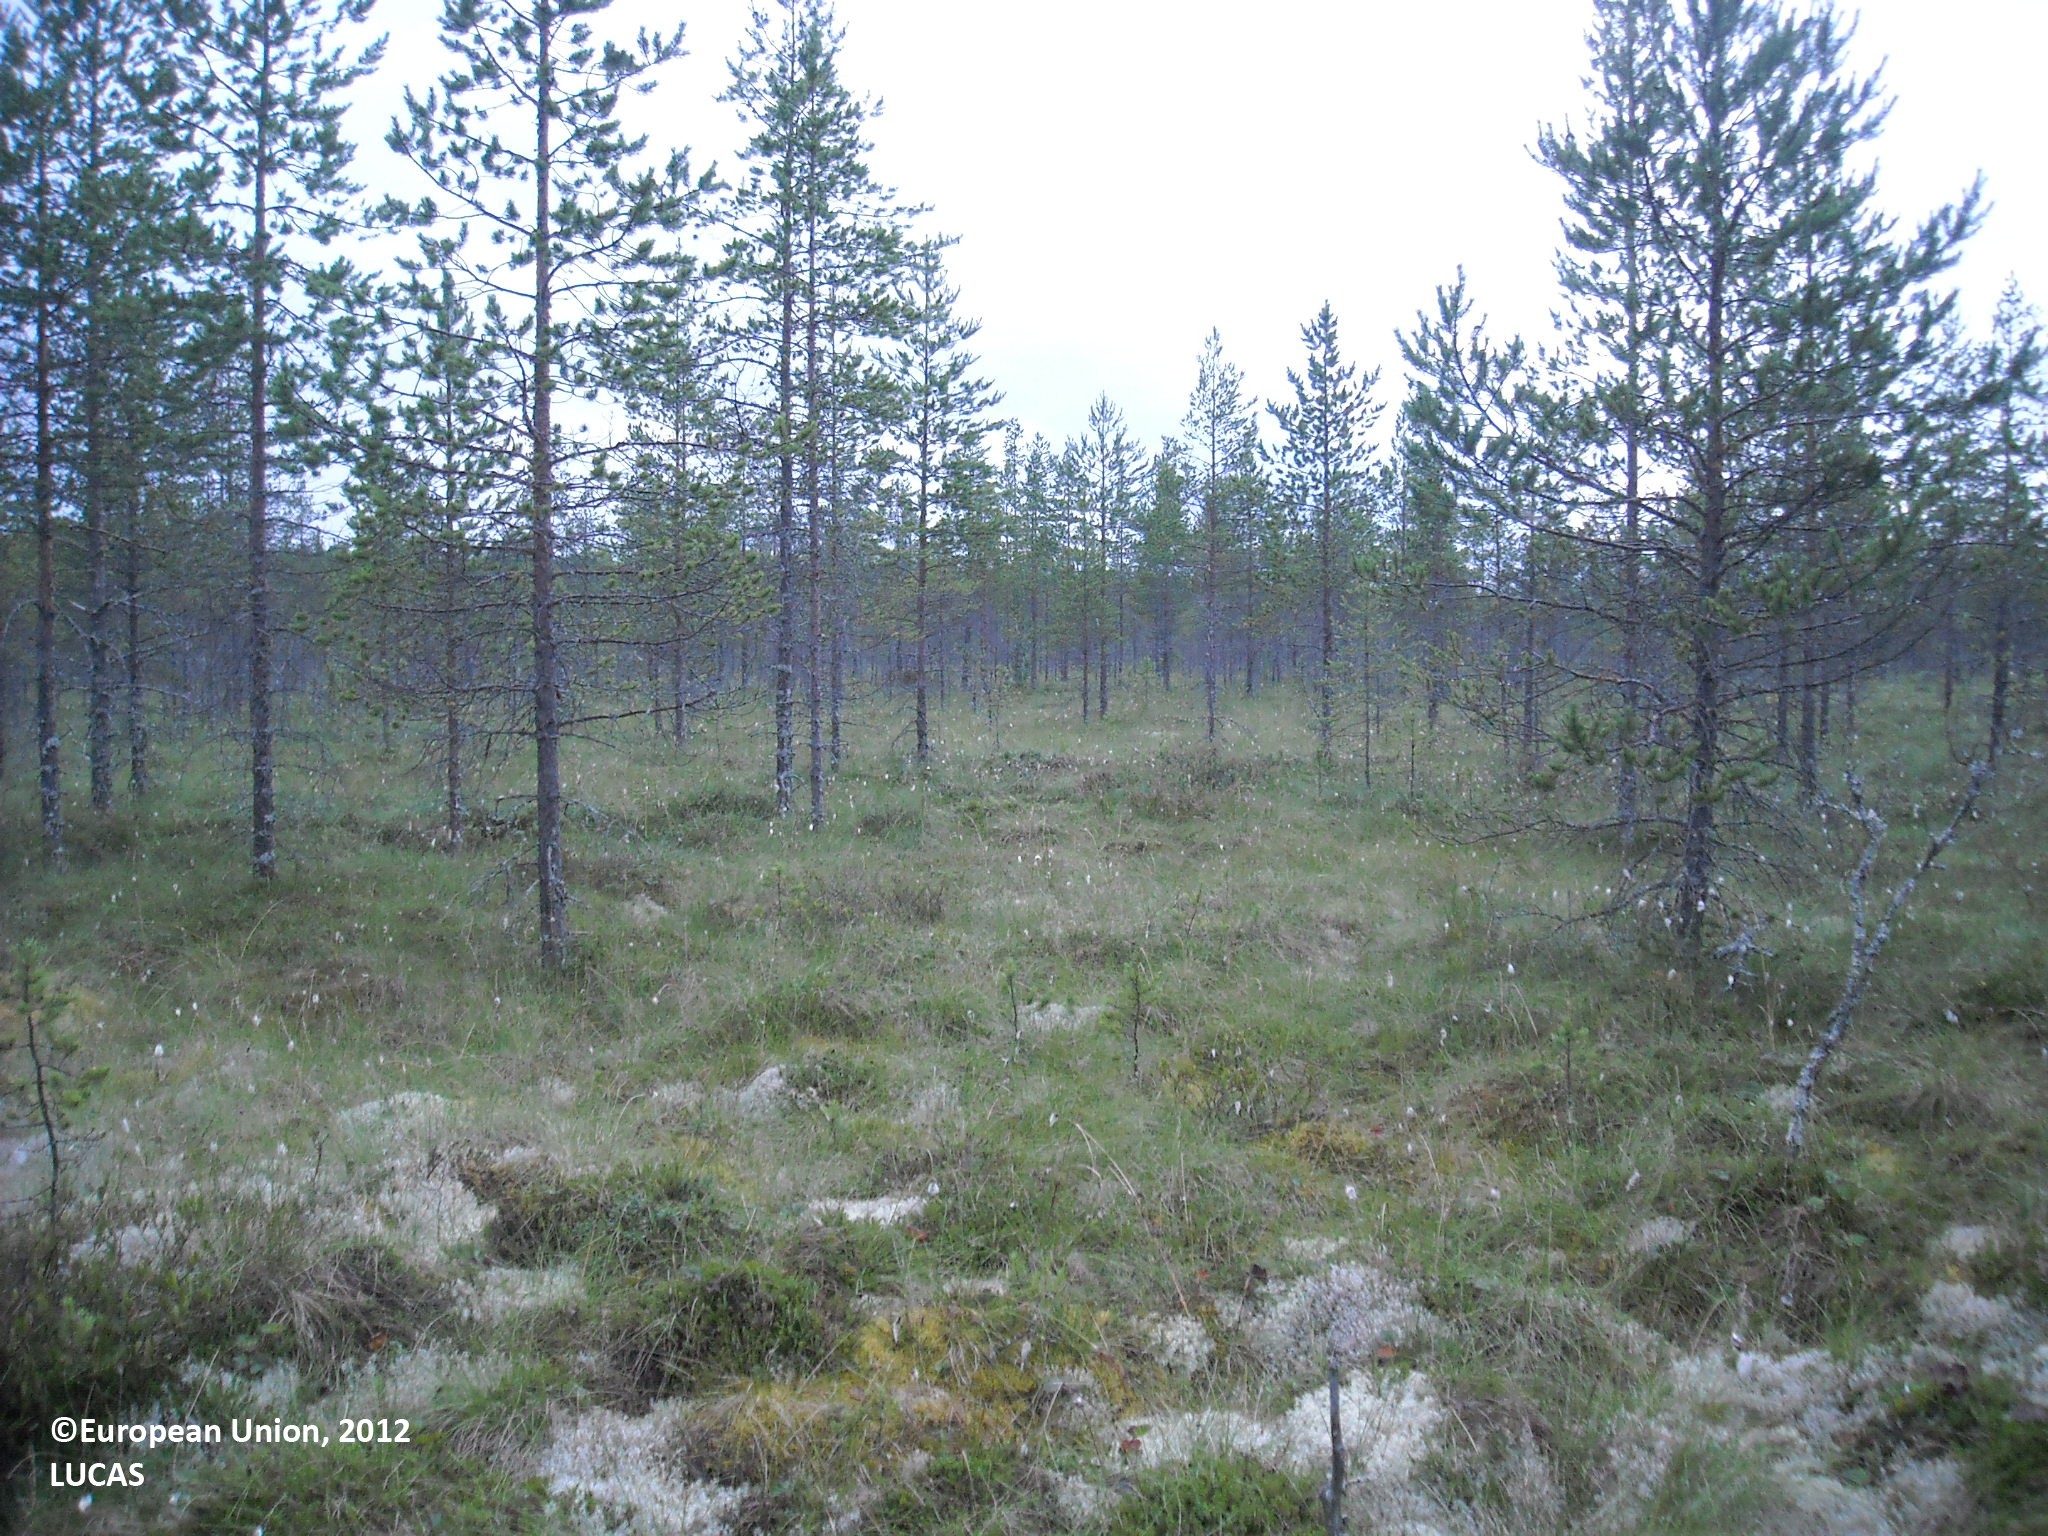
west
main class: Woodland
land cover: Pine dominated coniferous woodland
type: mire and swamp forests
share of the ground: 25 - 50 %
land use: Semi-natural and natural areas not in use
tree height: > 5 m
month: July
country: FI
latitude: 64.7958
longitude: 26.7654
